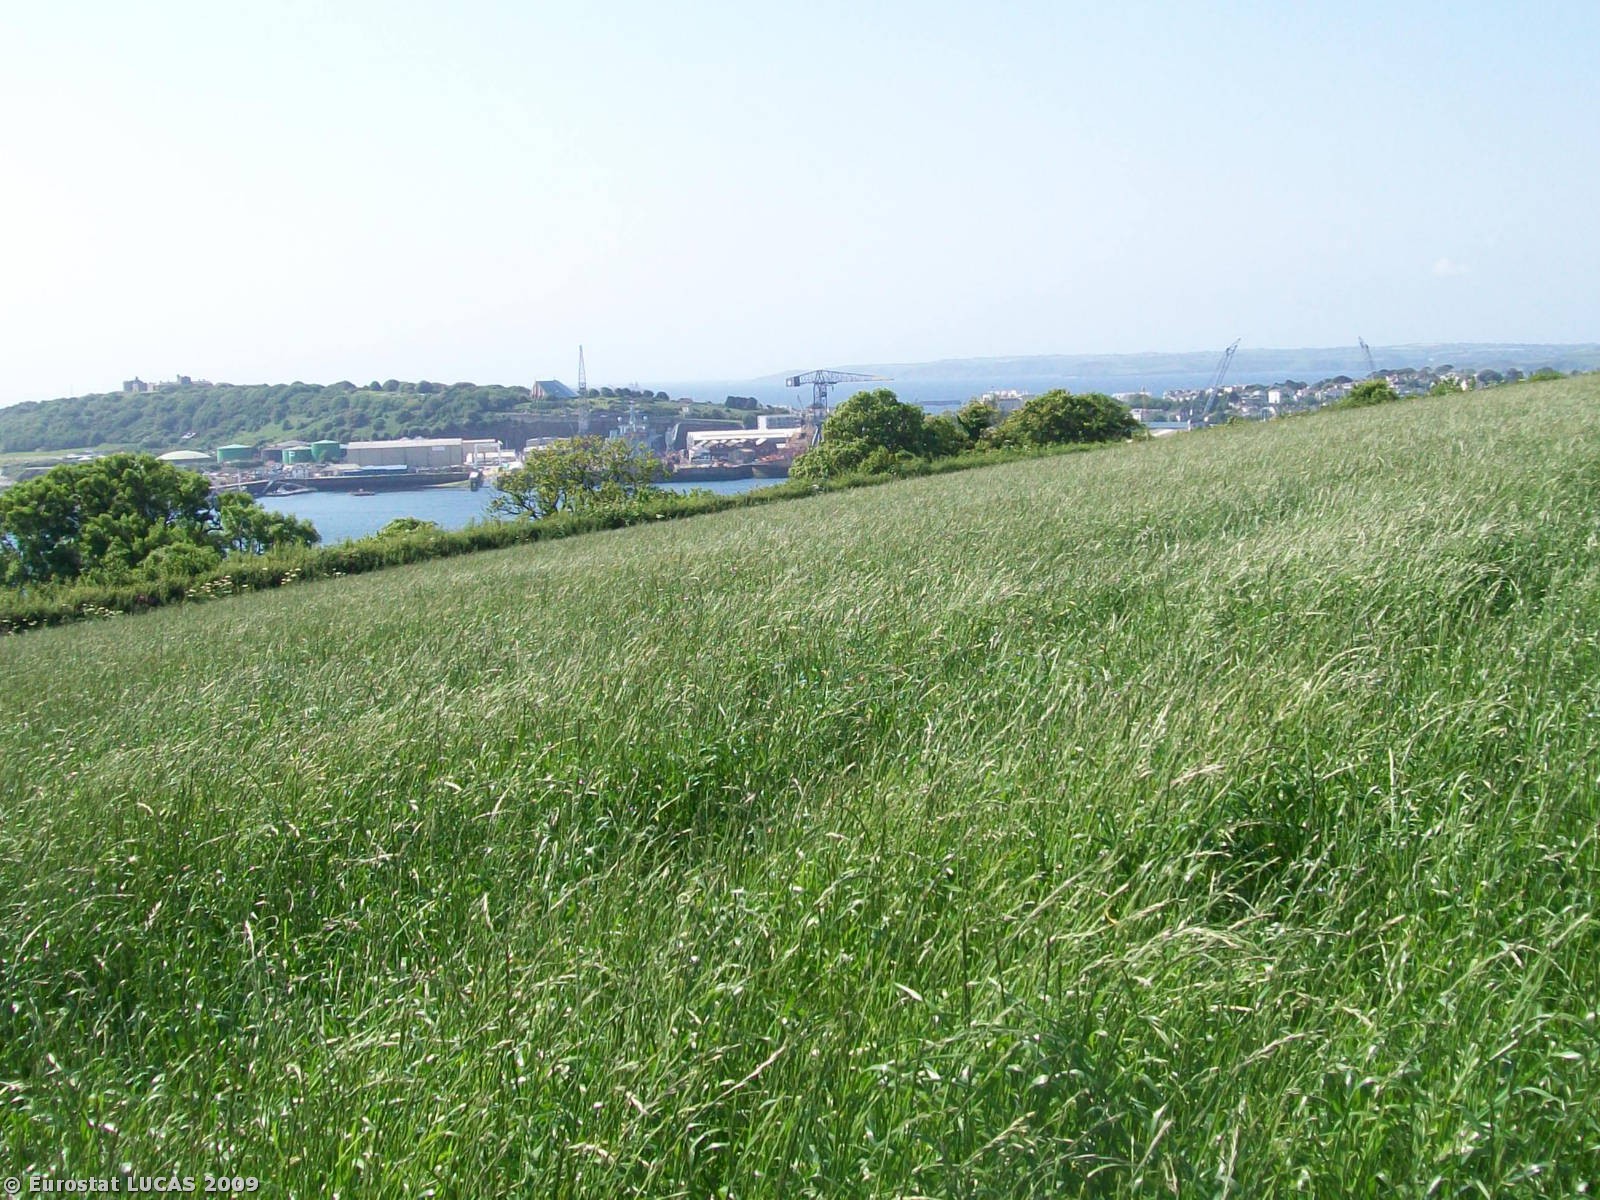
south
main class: Cropland
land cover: Temporary grasslands
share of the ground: > 75 %
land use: Agriculture (excluding fallow land and kitchen gardens)
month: June
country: GB
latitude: 50.1652
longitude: -5.0539
